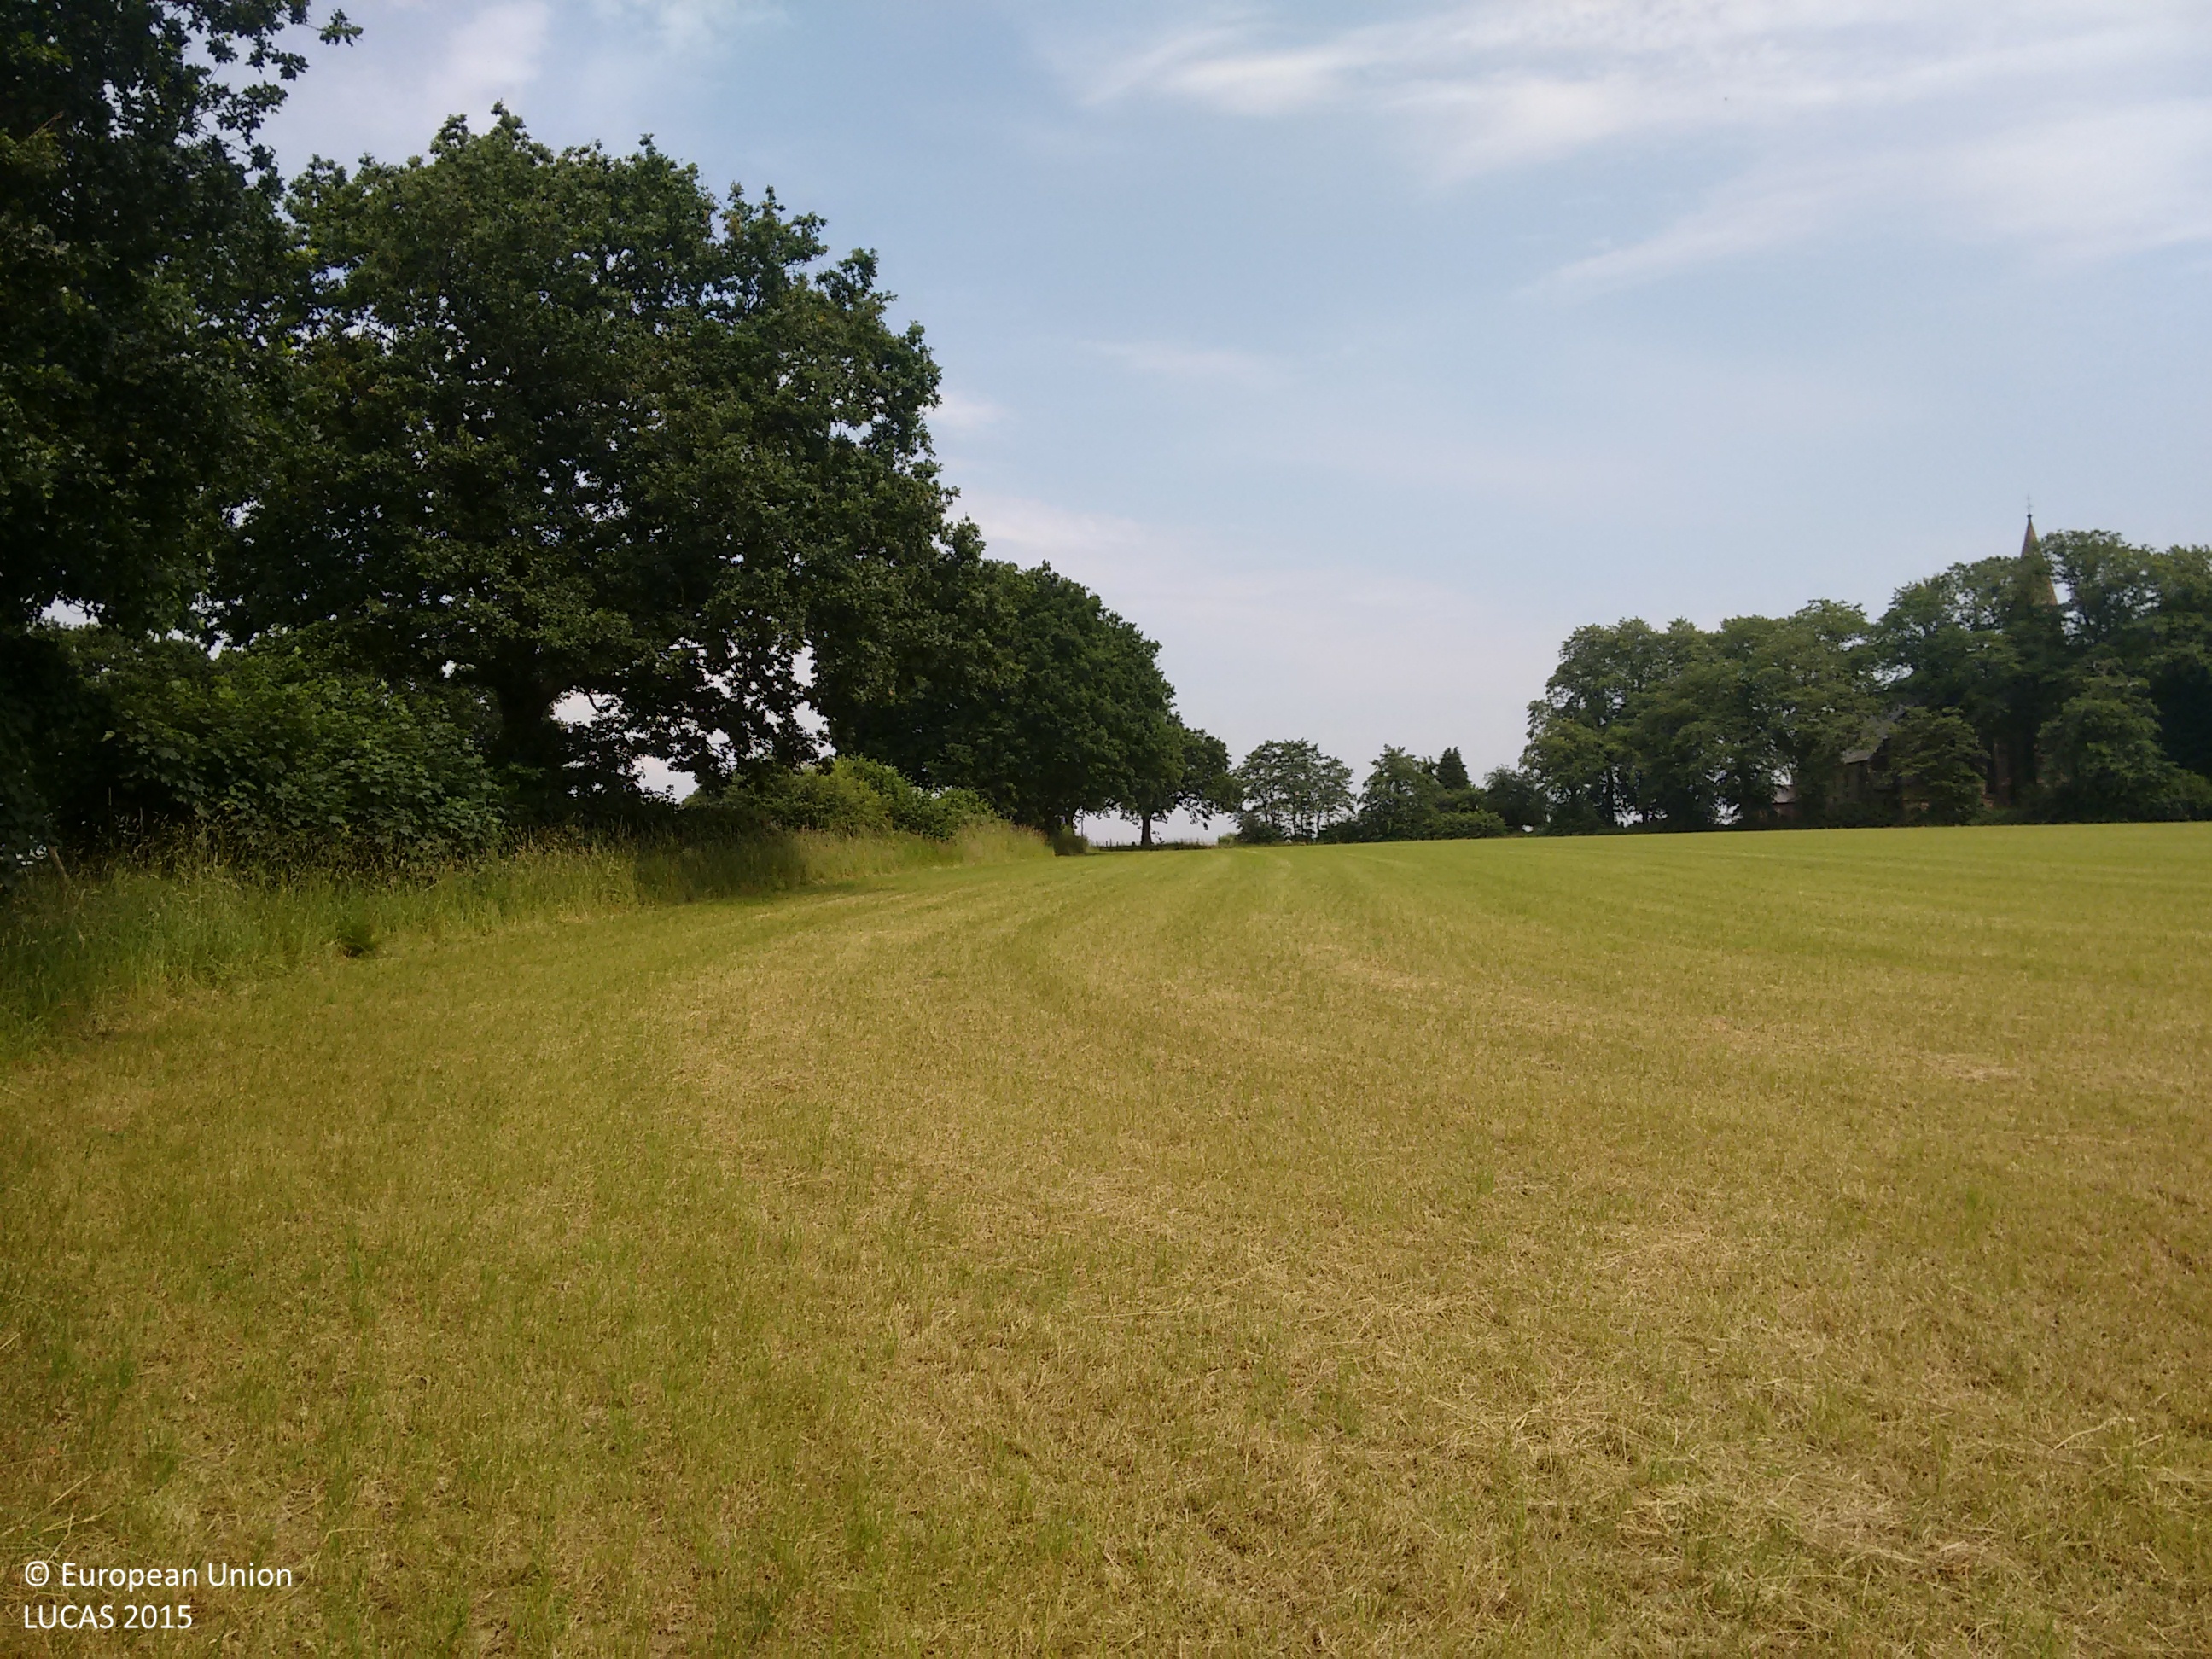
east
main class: Cropland
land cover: Temporary grasslands
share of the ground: > 75 %
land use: Agriculture (excluding fallow land and kitchen gardens)
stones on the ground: < 10 %
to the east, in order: Temporary grasslands; Broadleaved woodland; Fences; Grassland without tree/shrub cover; Fences; Paved roads, cycling and walking lanes; Grass margins; Fences; Grassland without tree/shrub cover; Fences; Grassland without tree/shrub cover
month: July
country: GB
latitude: 53.4381
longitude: -2.5457
